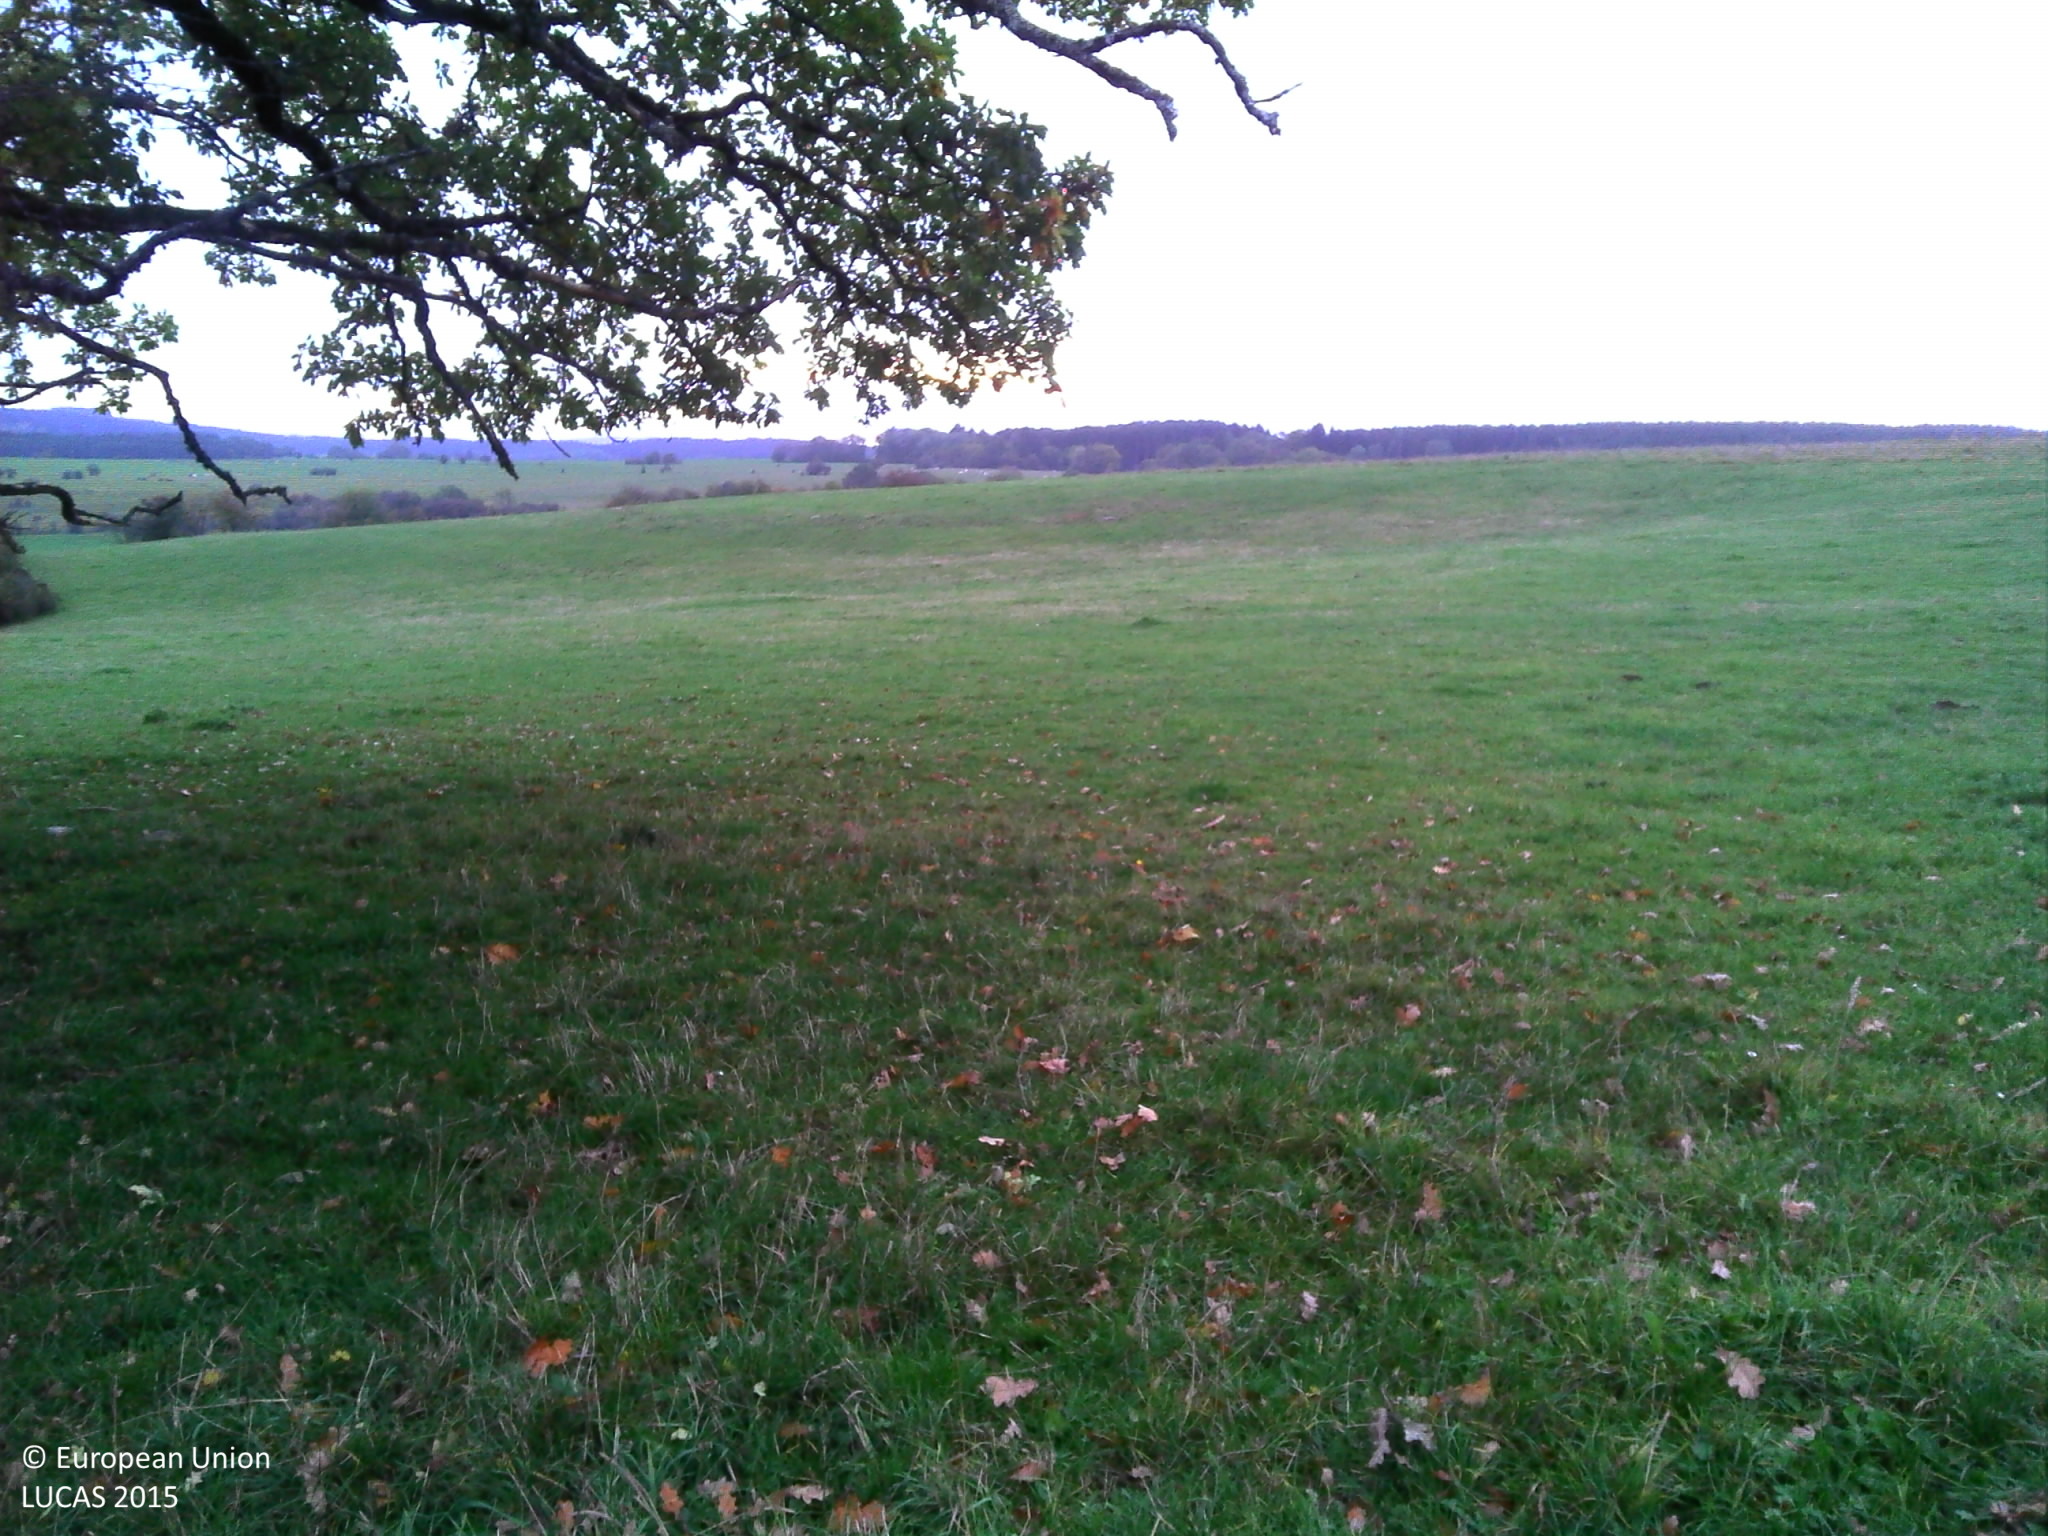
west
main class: Grassland
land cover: Grassland with sparse tree/shrub cover
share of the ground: > 75 %
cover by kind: herbaceous plants 95 %, broadleaved forest trees 5 %
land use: Agriculture (excluding fallow land and kitchen gardens)
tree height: > 5 m
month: October
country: FR
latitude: 46.9887
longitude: 6.2550
